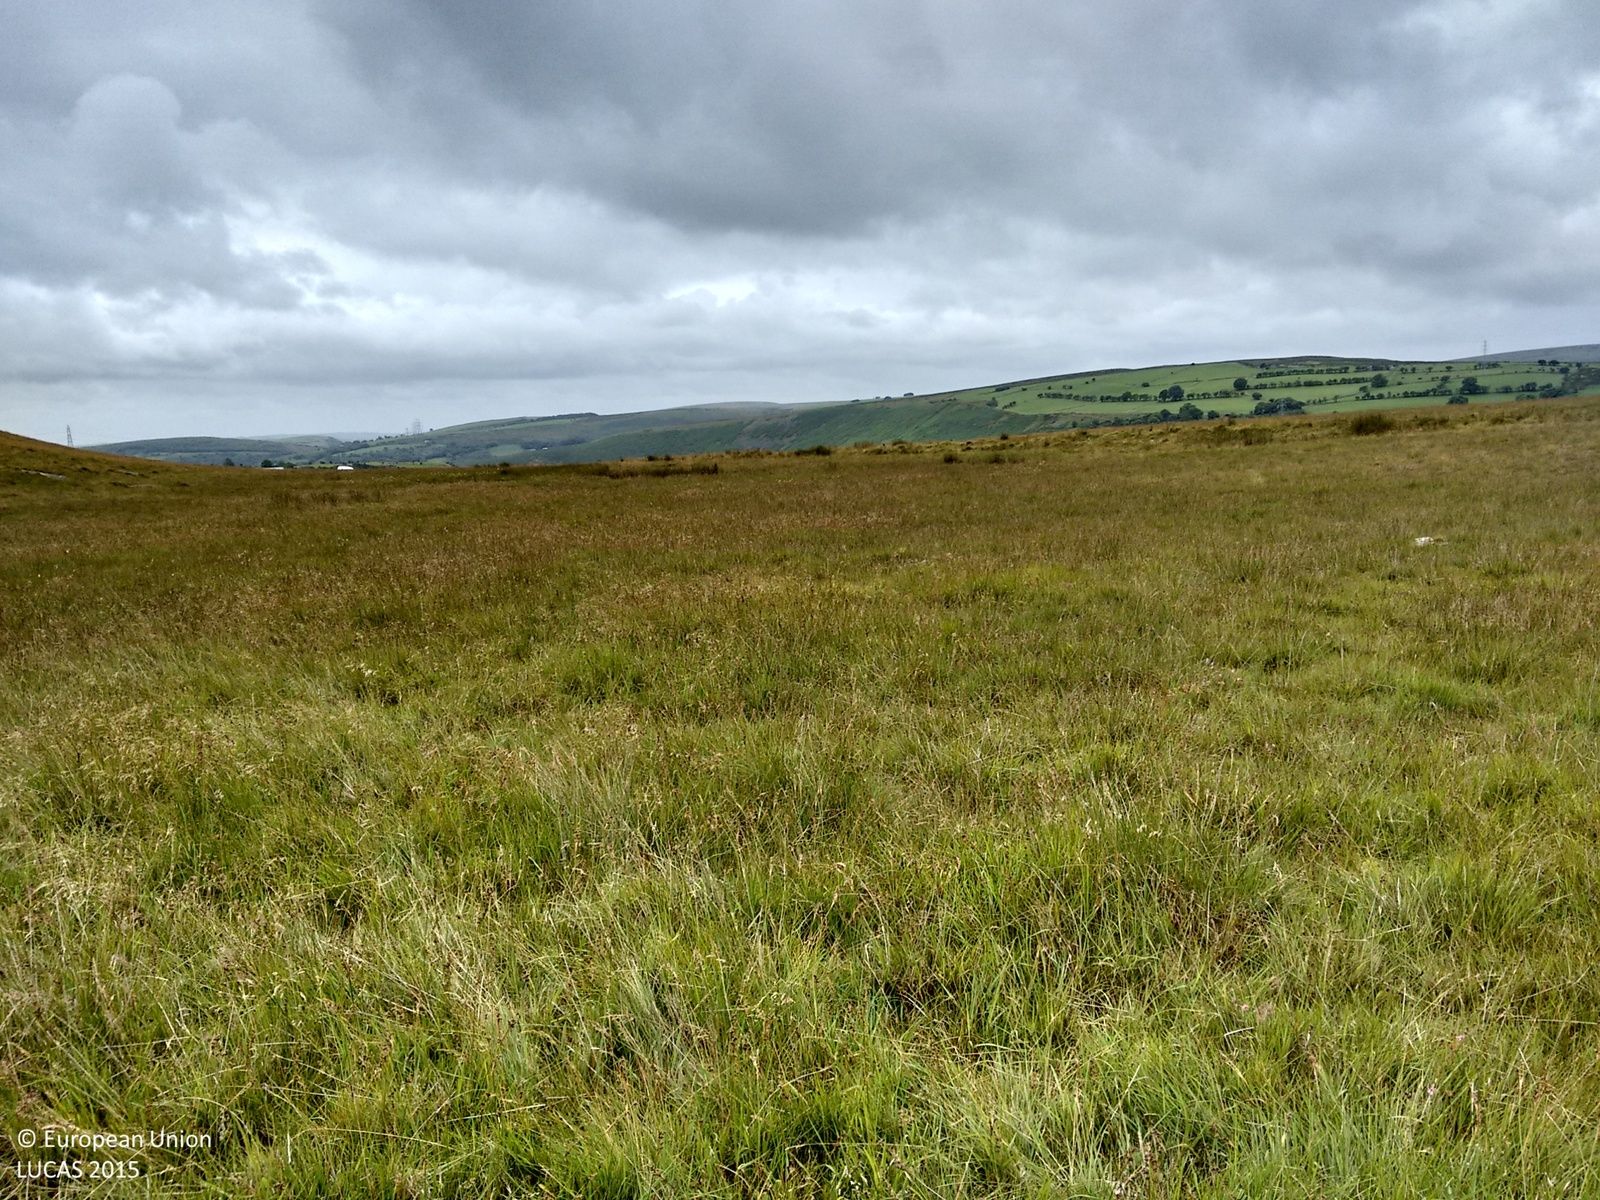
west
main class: Grassland
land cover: Grassland without tree/shrub cover
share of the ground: > 75 %
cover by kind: herbaceous plants 100 %
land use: Agriculture (excluding fallow land and kitchen gardens)
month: July
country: GB
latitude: 51.7621
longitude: -3.8414
